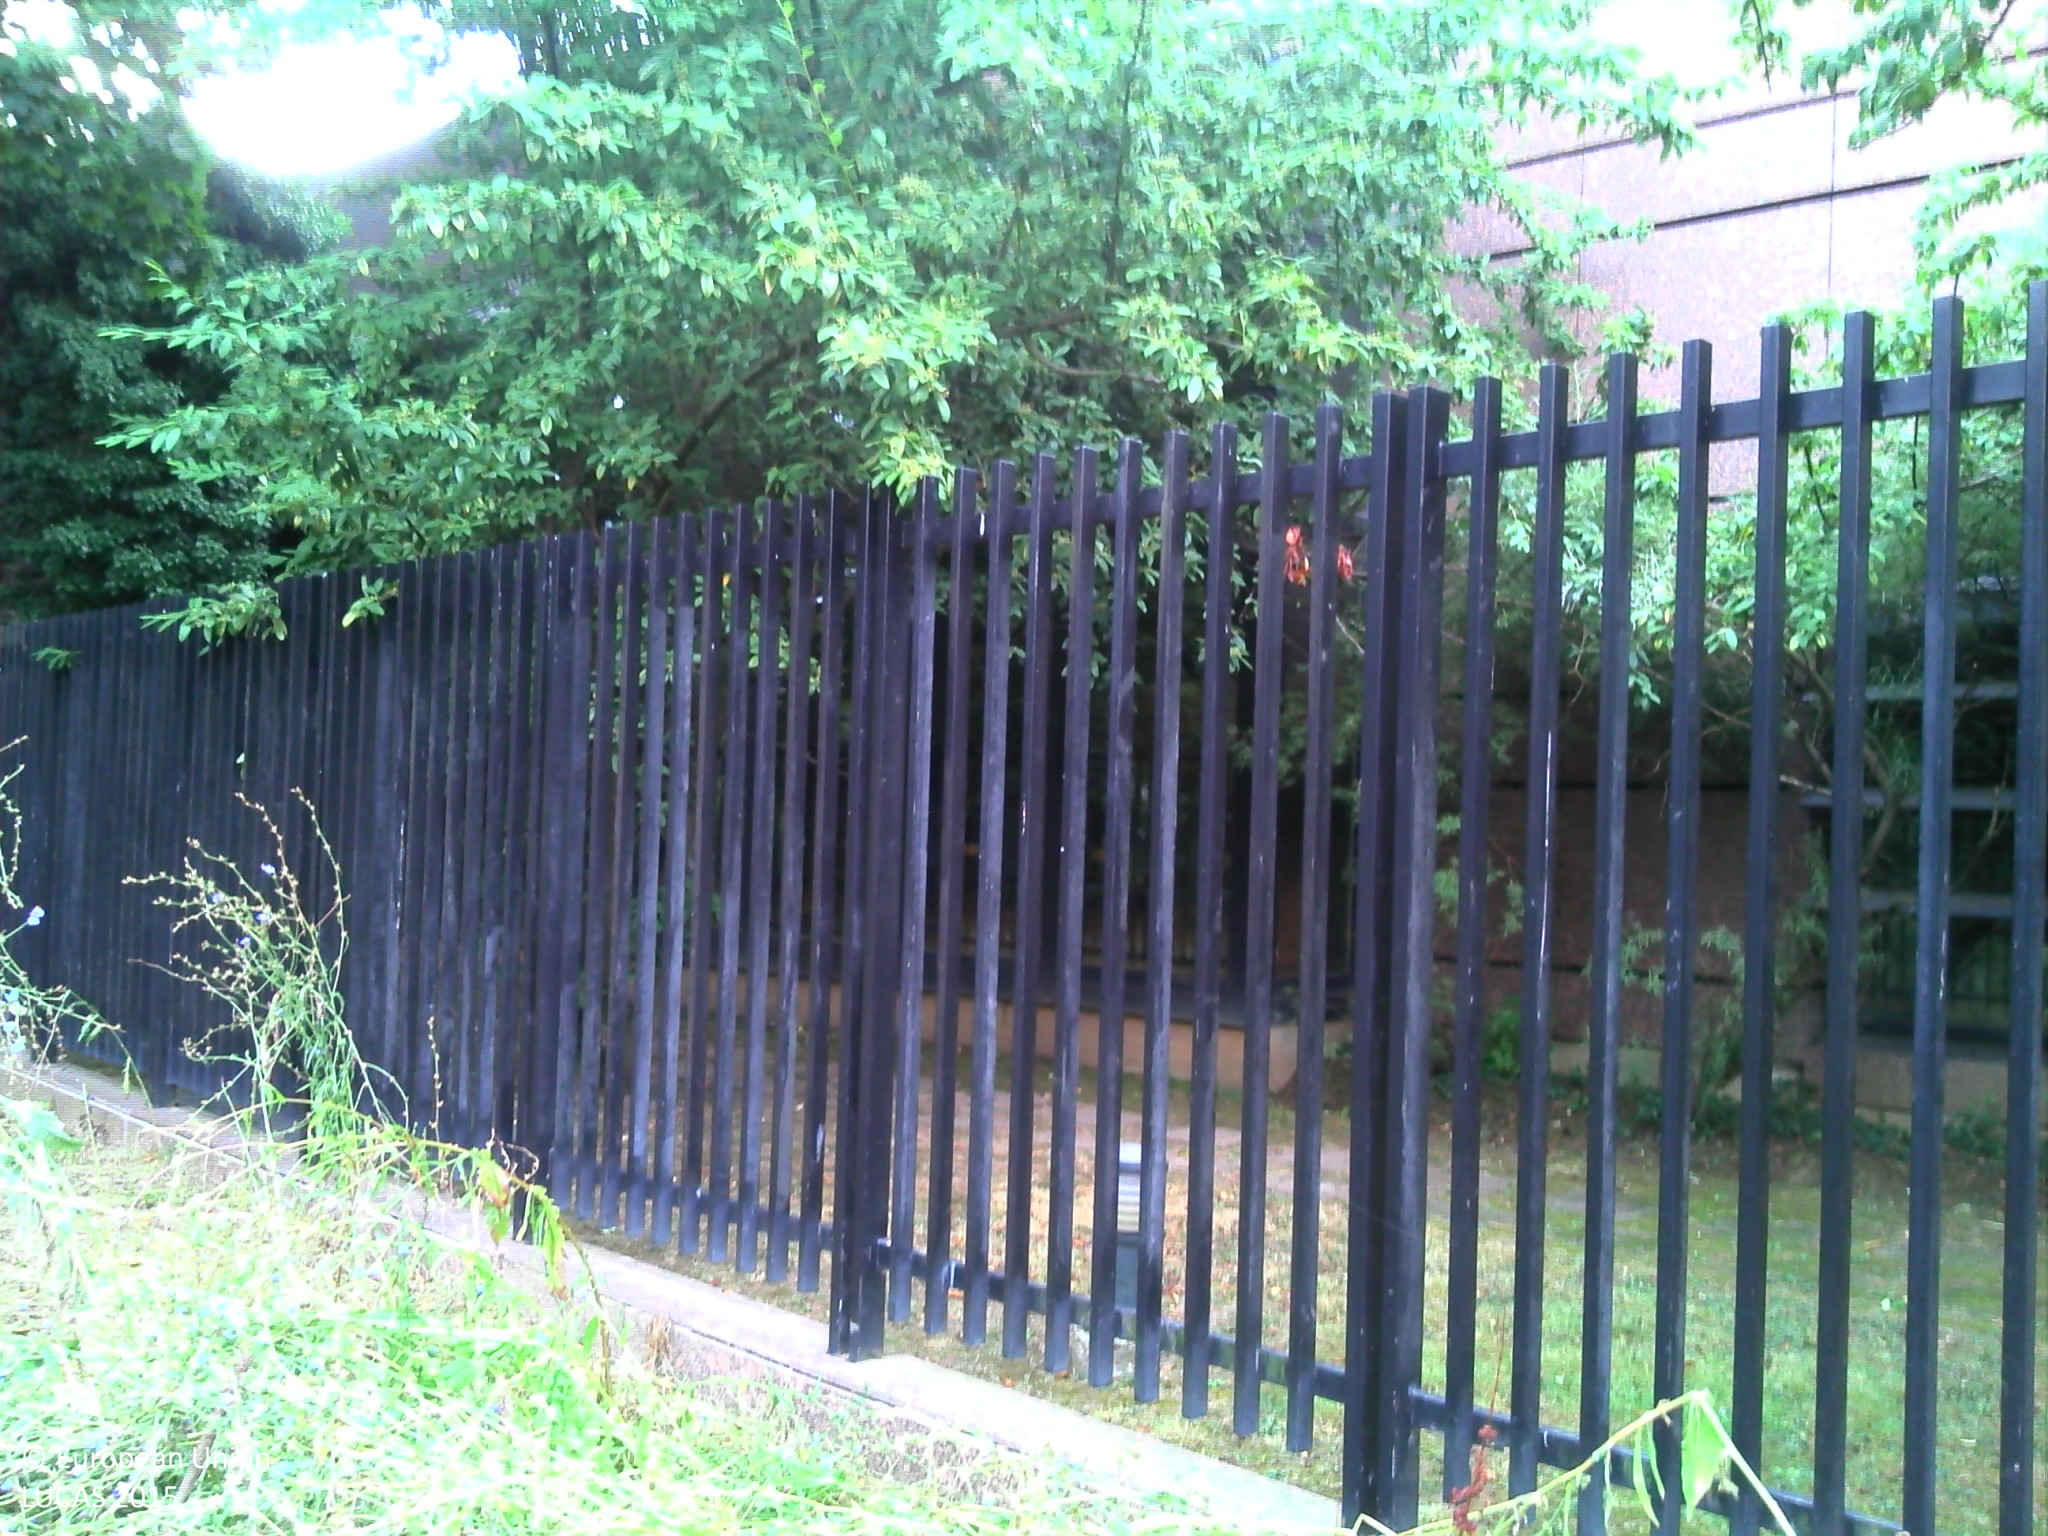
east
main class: Grassland
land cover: Spontaneously vegetated surfaces
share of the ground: > 75 %
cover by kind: herbaceous plants 100 %
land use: Community services
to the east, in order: Spontaneously vegetated surfaces; Artificial constructions in urban areas
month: August
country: FR
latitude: 48.5784
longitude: 7.7372
